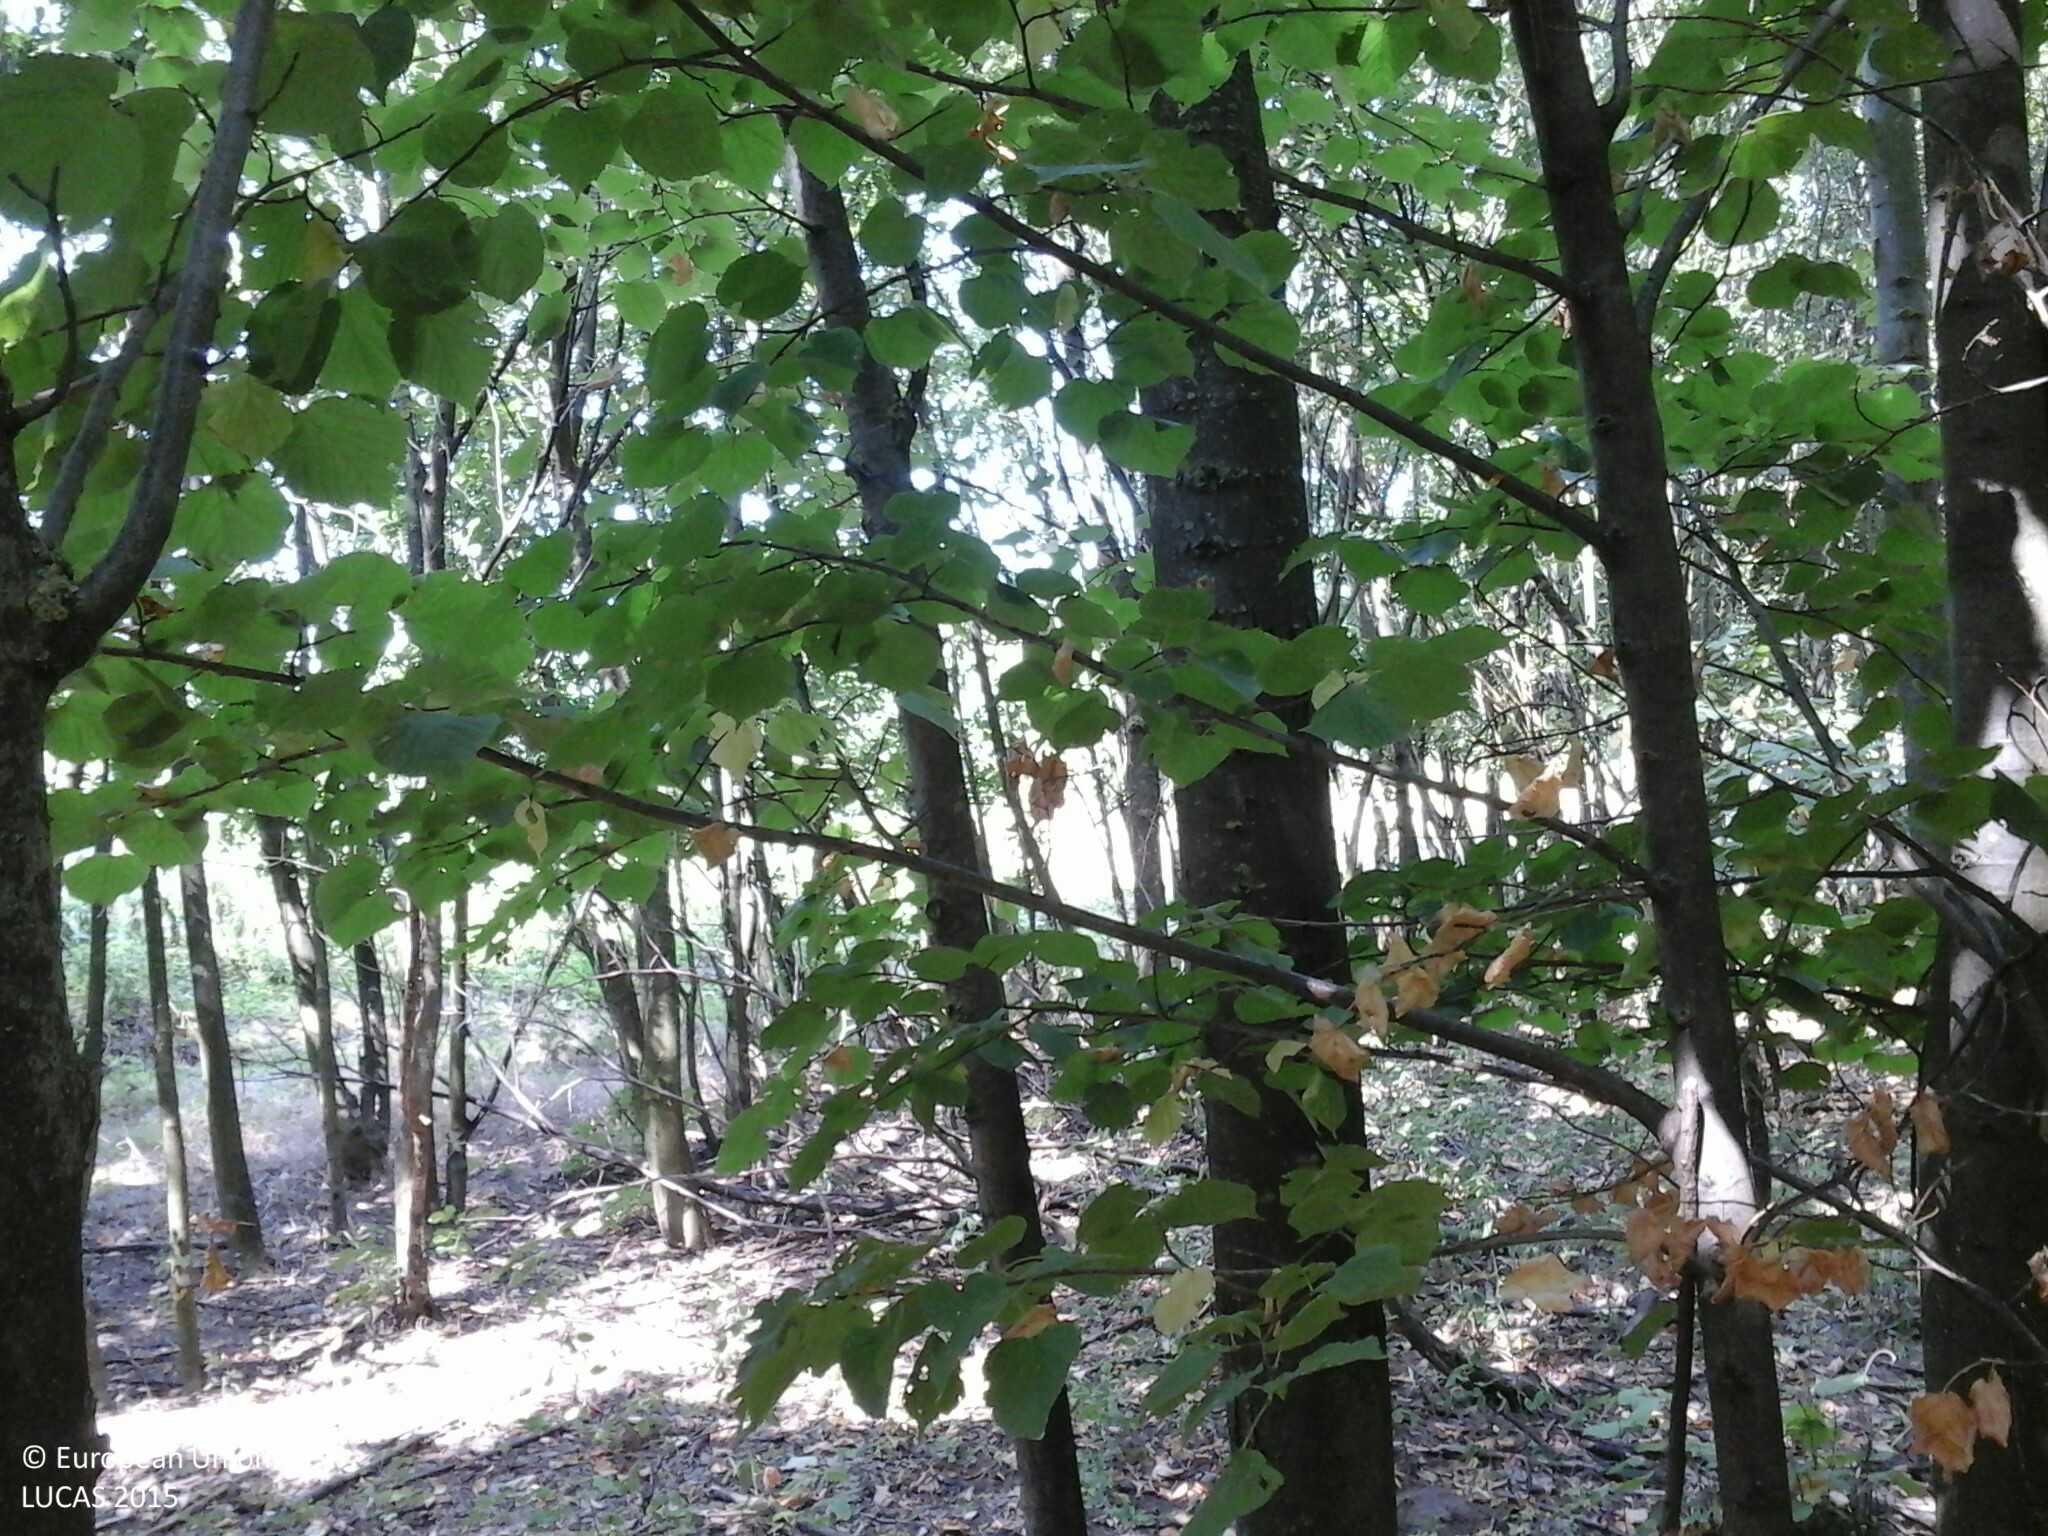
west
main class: Woodland
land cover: Broadleaved woodland
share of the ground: > 75 %
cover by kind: broadleaved forest trees 100 %
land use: Forestry
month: August
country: HU
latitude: 46.9214
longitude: 18.2176
